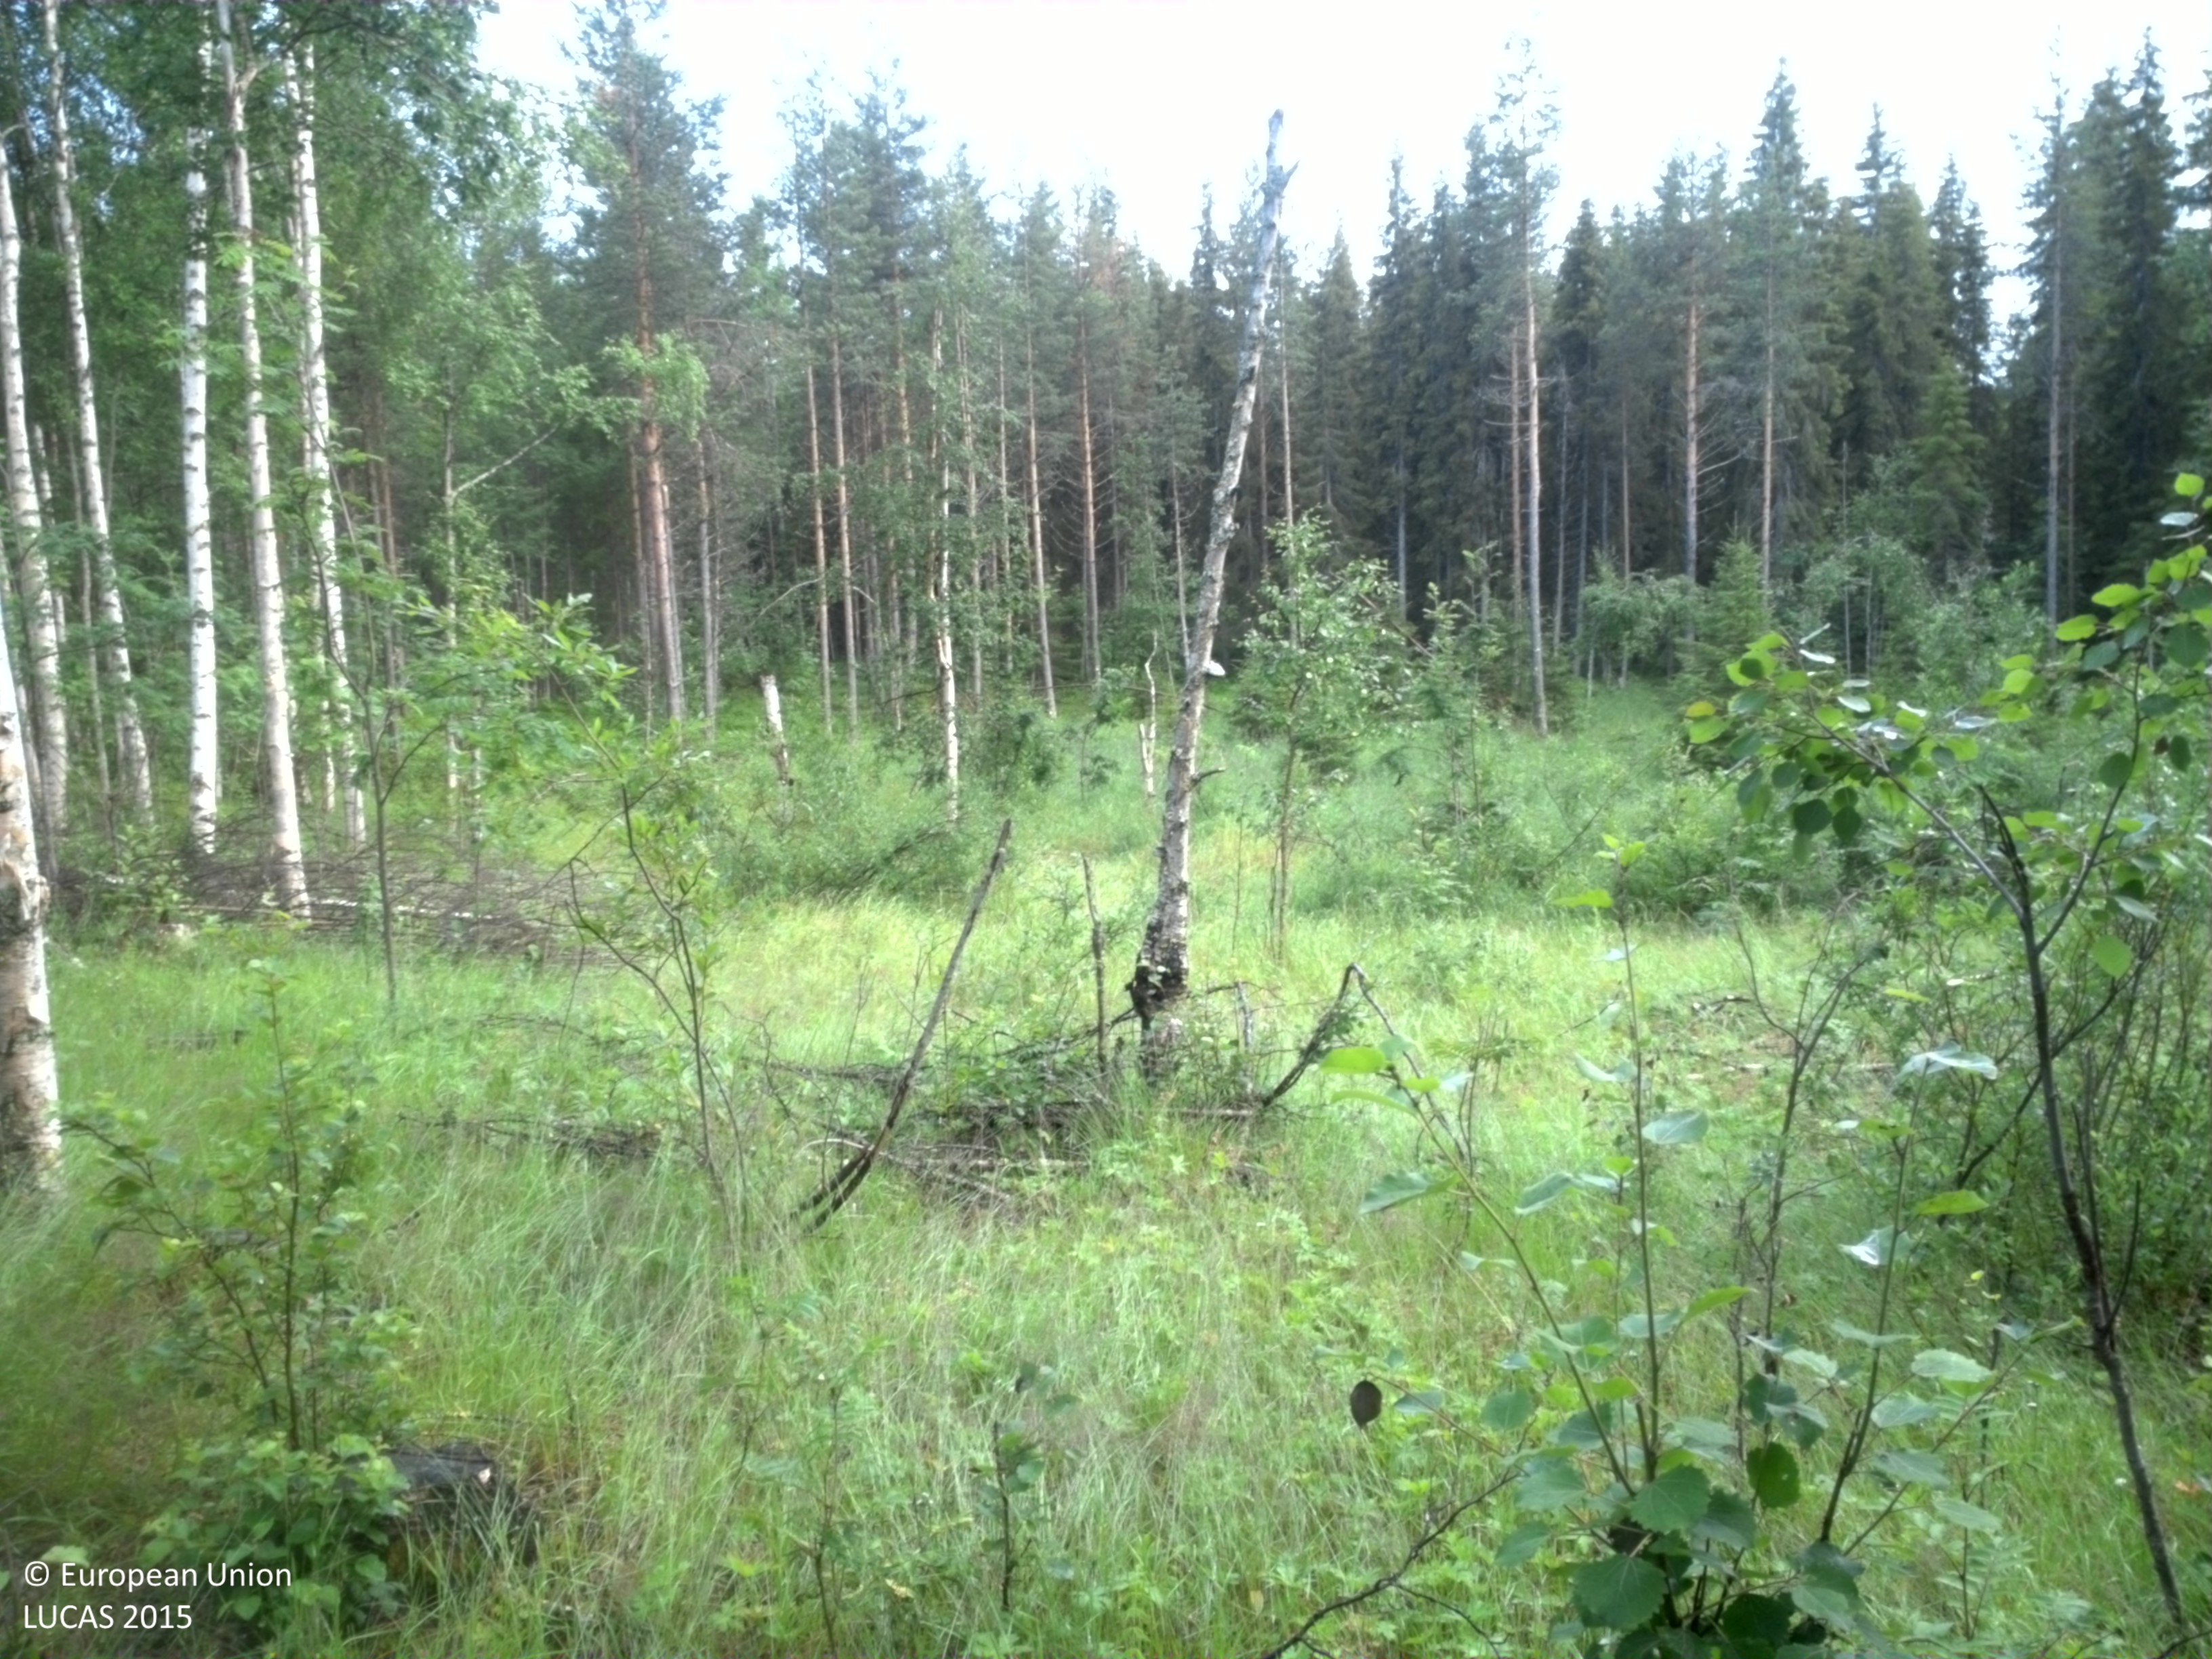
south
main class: Grassland
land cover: Grassland with sparse tree/shrub cover
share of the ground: > 75 %
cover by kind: herbaceous plants 85 %, shrubs 10 %, broadleaved forest trees 5 %
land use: Abandoned areas
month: July
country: SE
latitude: 66.1381
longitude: 20.3938
